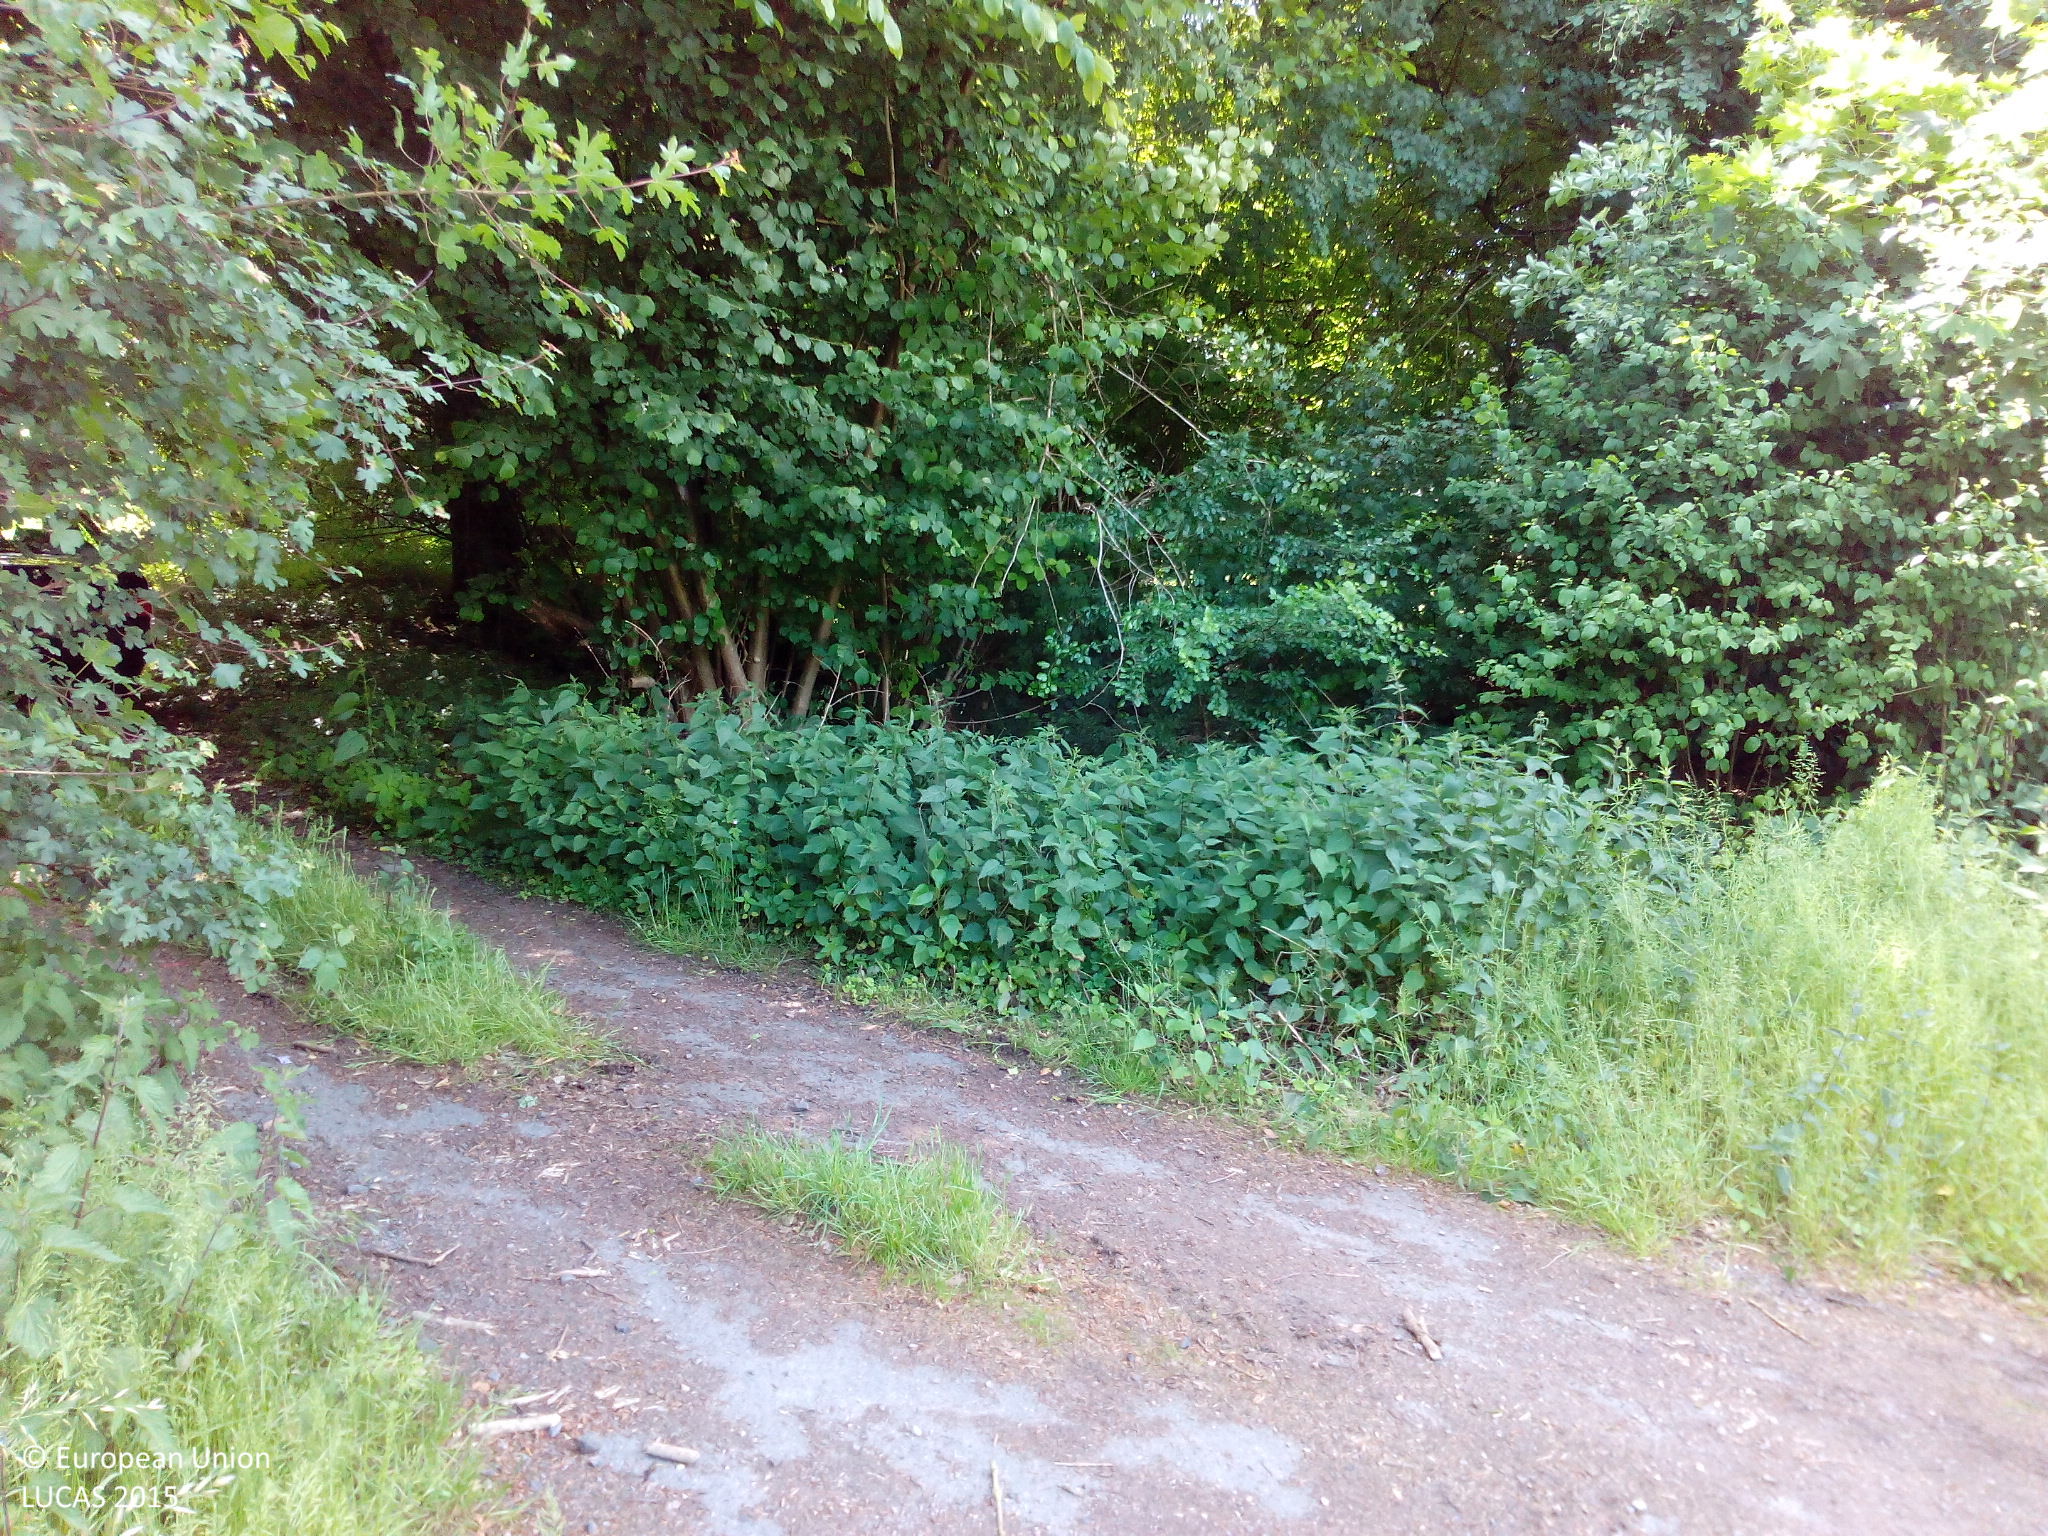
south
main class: Woodland
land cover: Broadleaved woodland
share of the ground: > 75 %
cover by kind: broadleaved forest trees 100 %
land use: Semi-natural and natural areas not in use
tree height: > 5 m
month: June
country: DE
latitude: 51.3897
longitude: 8.0028
